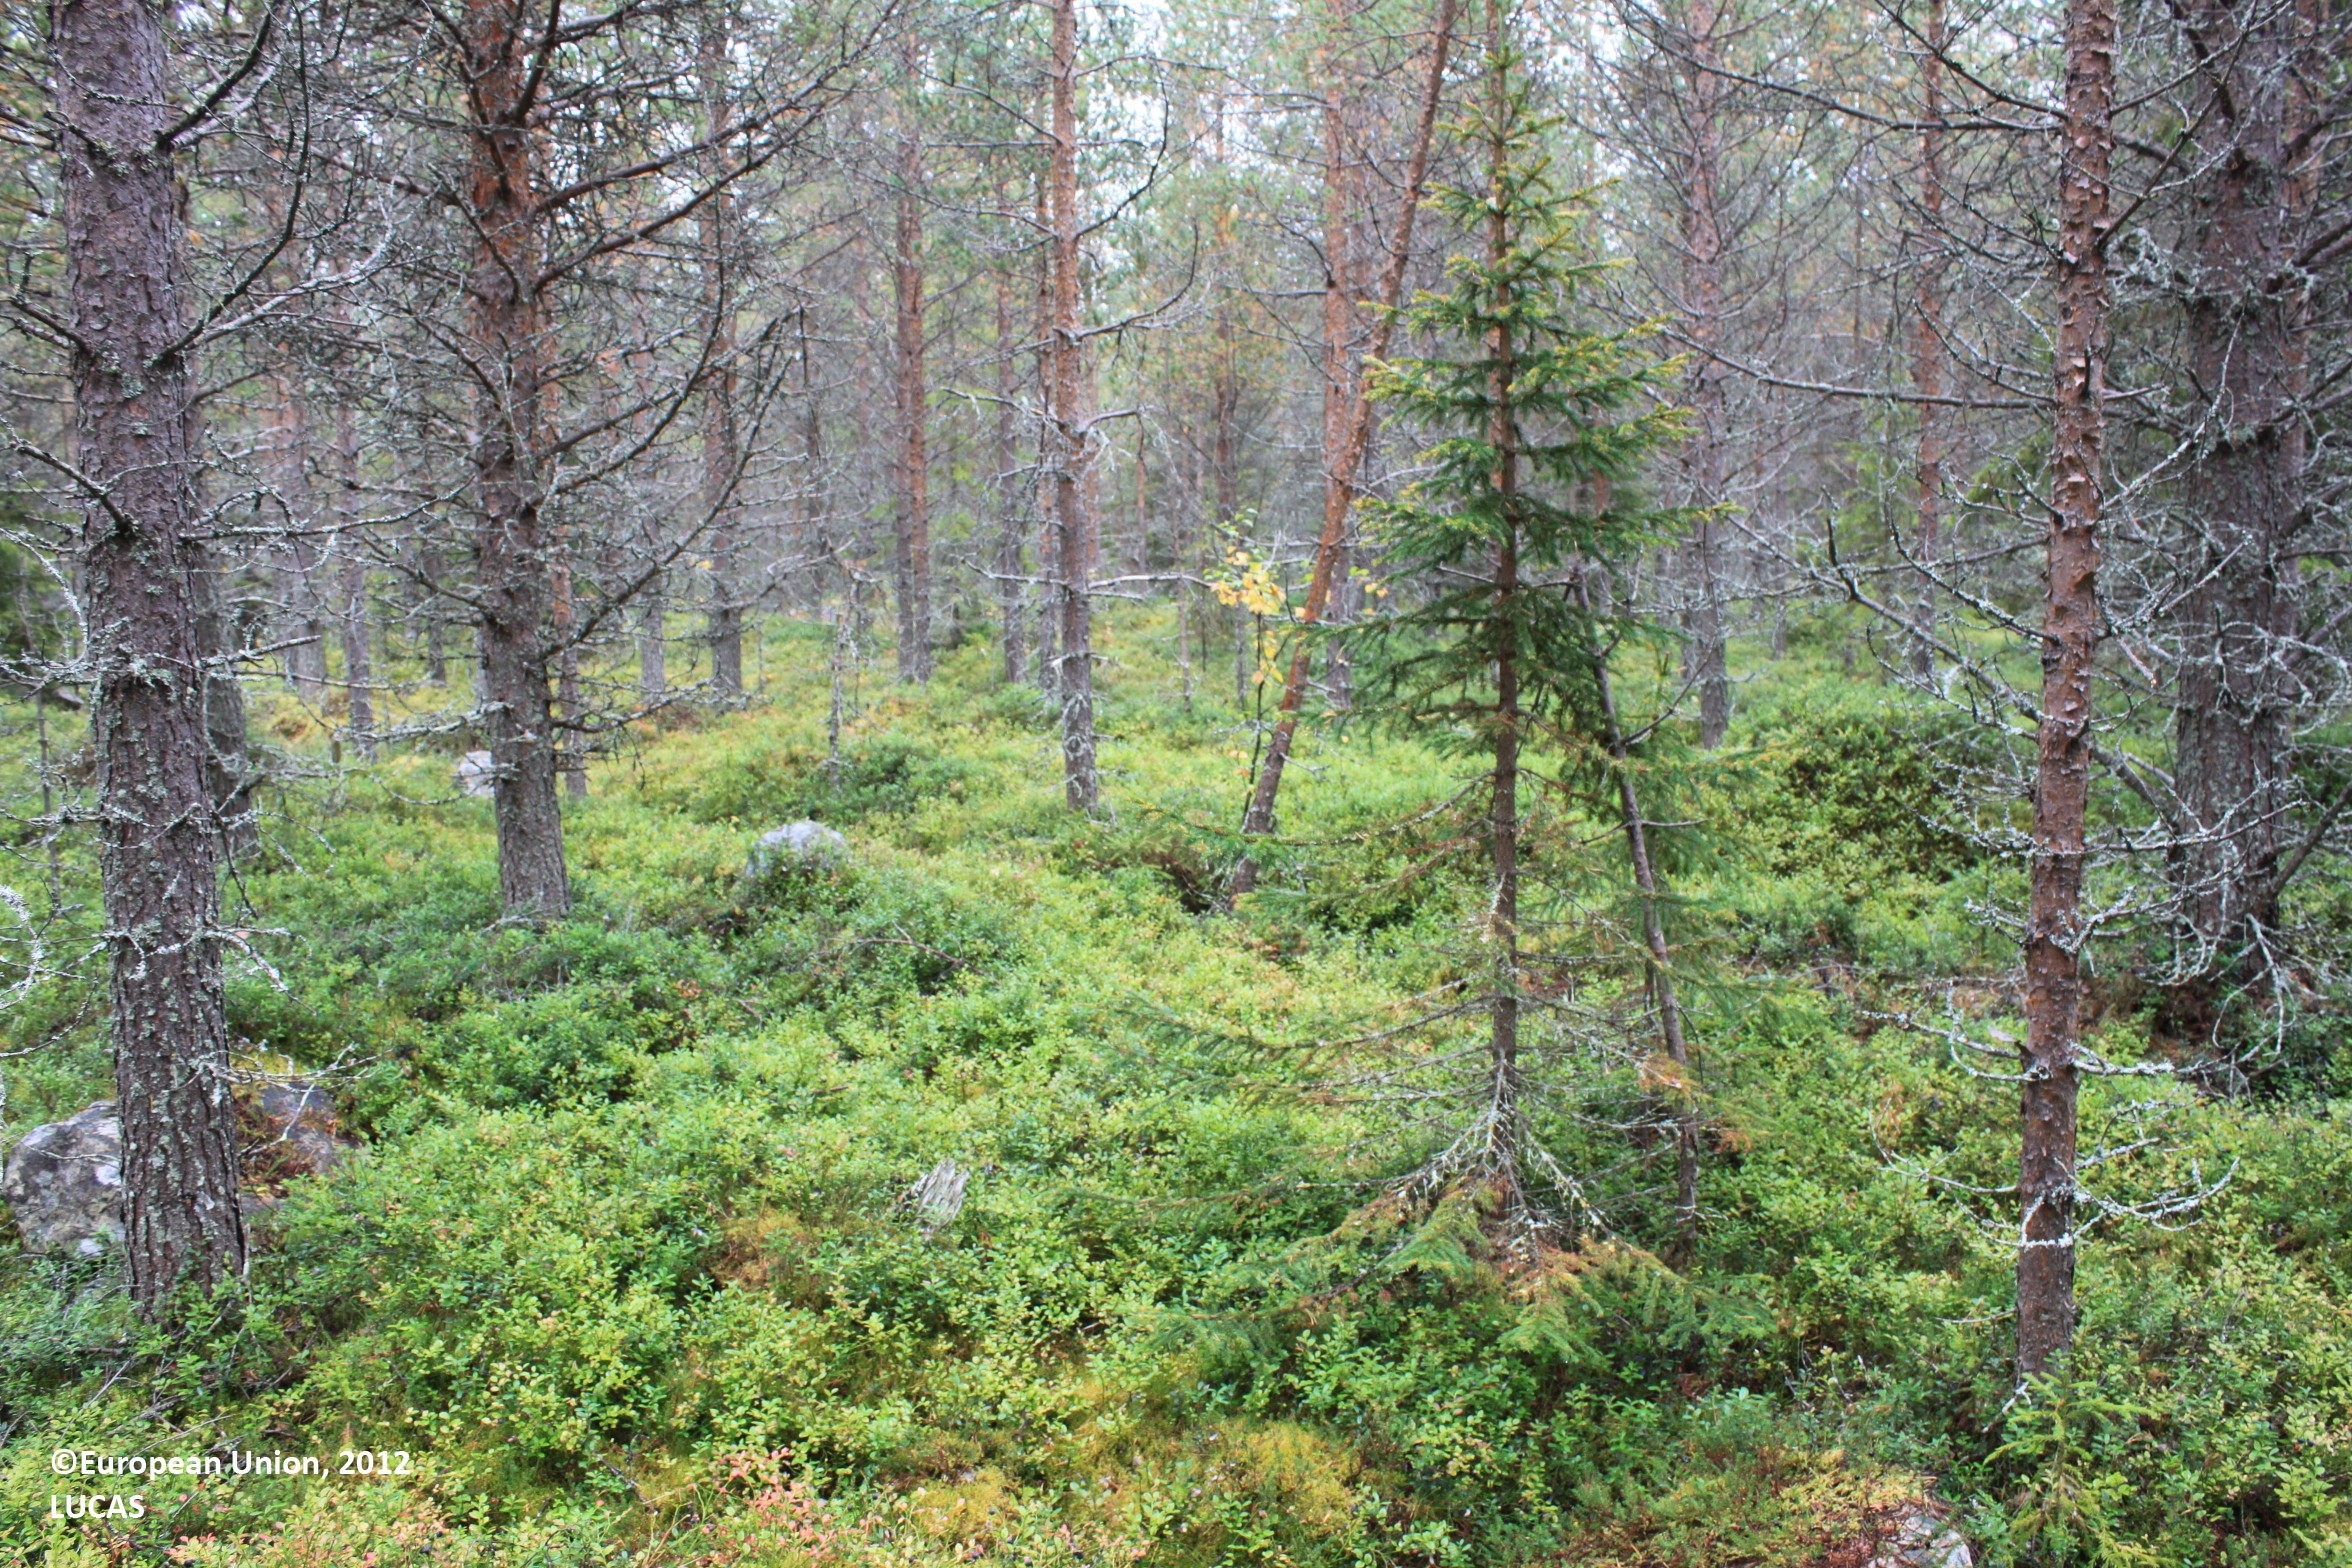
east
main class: Woodland
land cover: Pine dominated coniferous woodland
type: boreal forest
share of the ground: 25 - 50 %
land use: Forestry
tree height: > 5 m
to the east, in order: Pine dominated coniferous woodland; Ditches and canals; Pine dominated coniferous woodland; Ditches and canals; Peatbogs
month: September
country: FI
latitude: 65.8892
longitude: 27.3404
